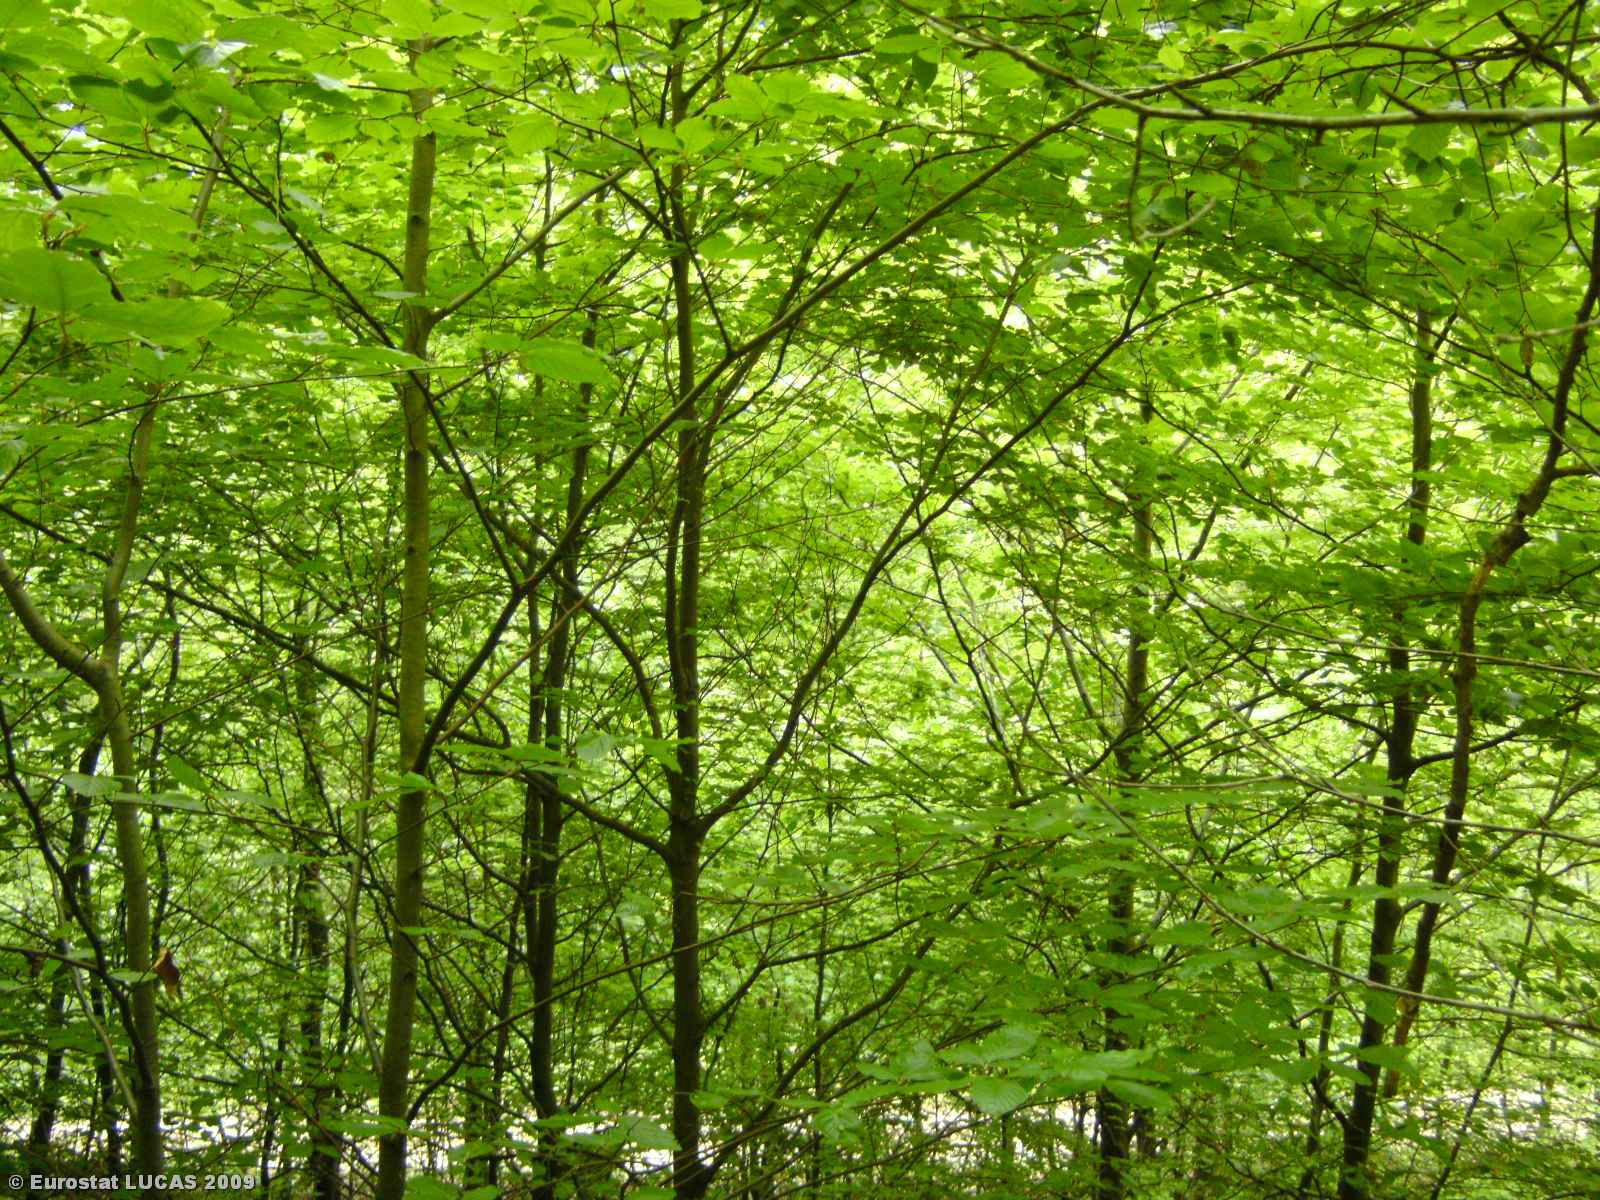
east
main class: Woodland
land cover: Broadleaved woodland
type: beech forest
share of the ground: > 75 %
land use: Forestry
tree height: > 5 m
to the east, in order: Broadleaved woodland; Grassland with sparse tree/shrub cover
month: May
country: LU
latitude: 49.7404
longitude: 6.1279
